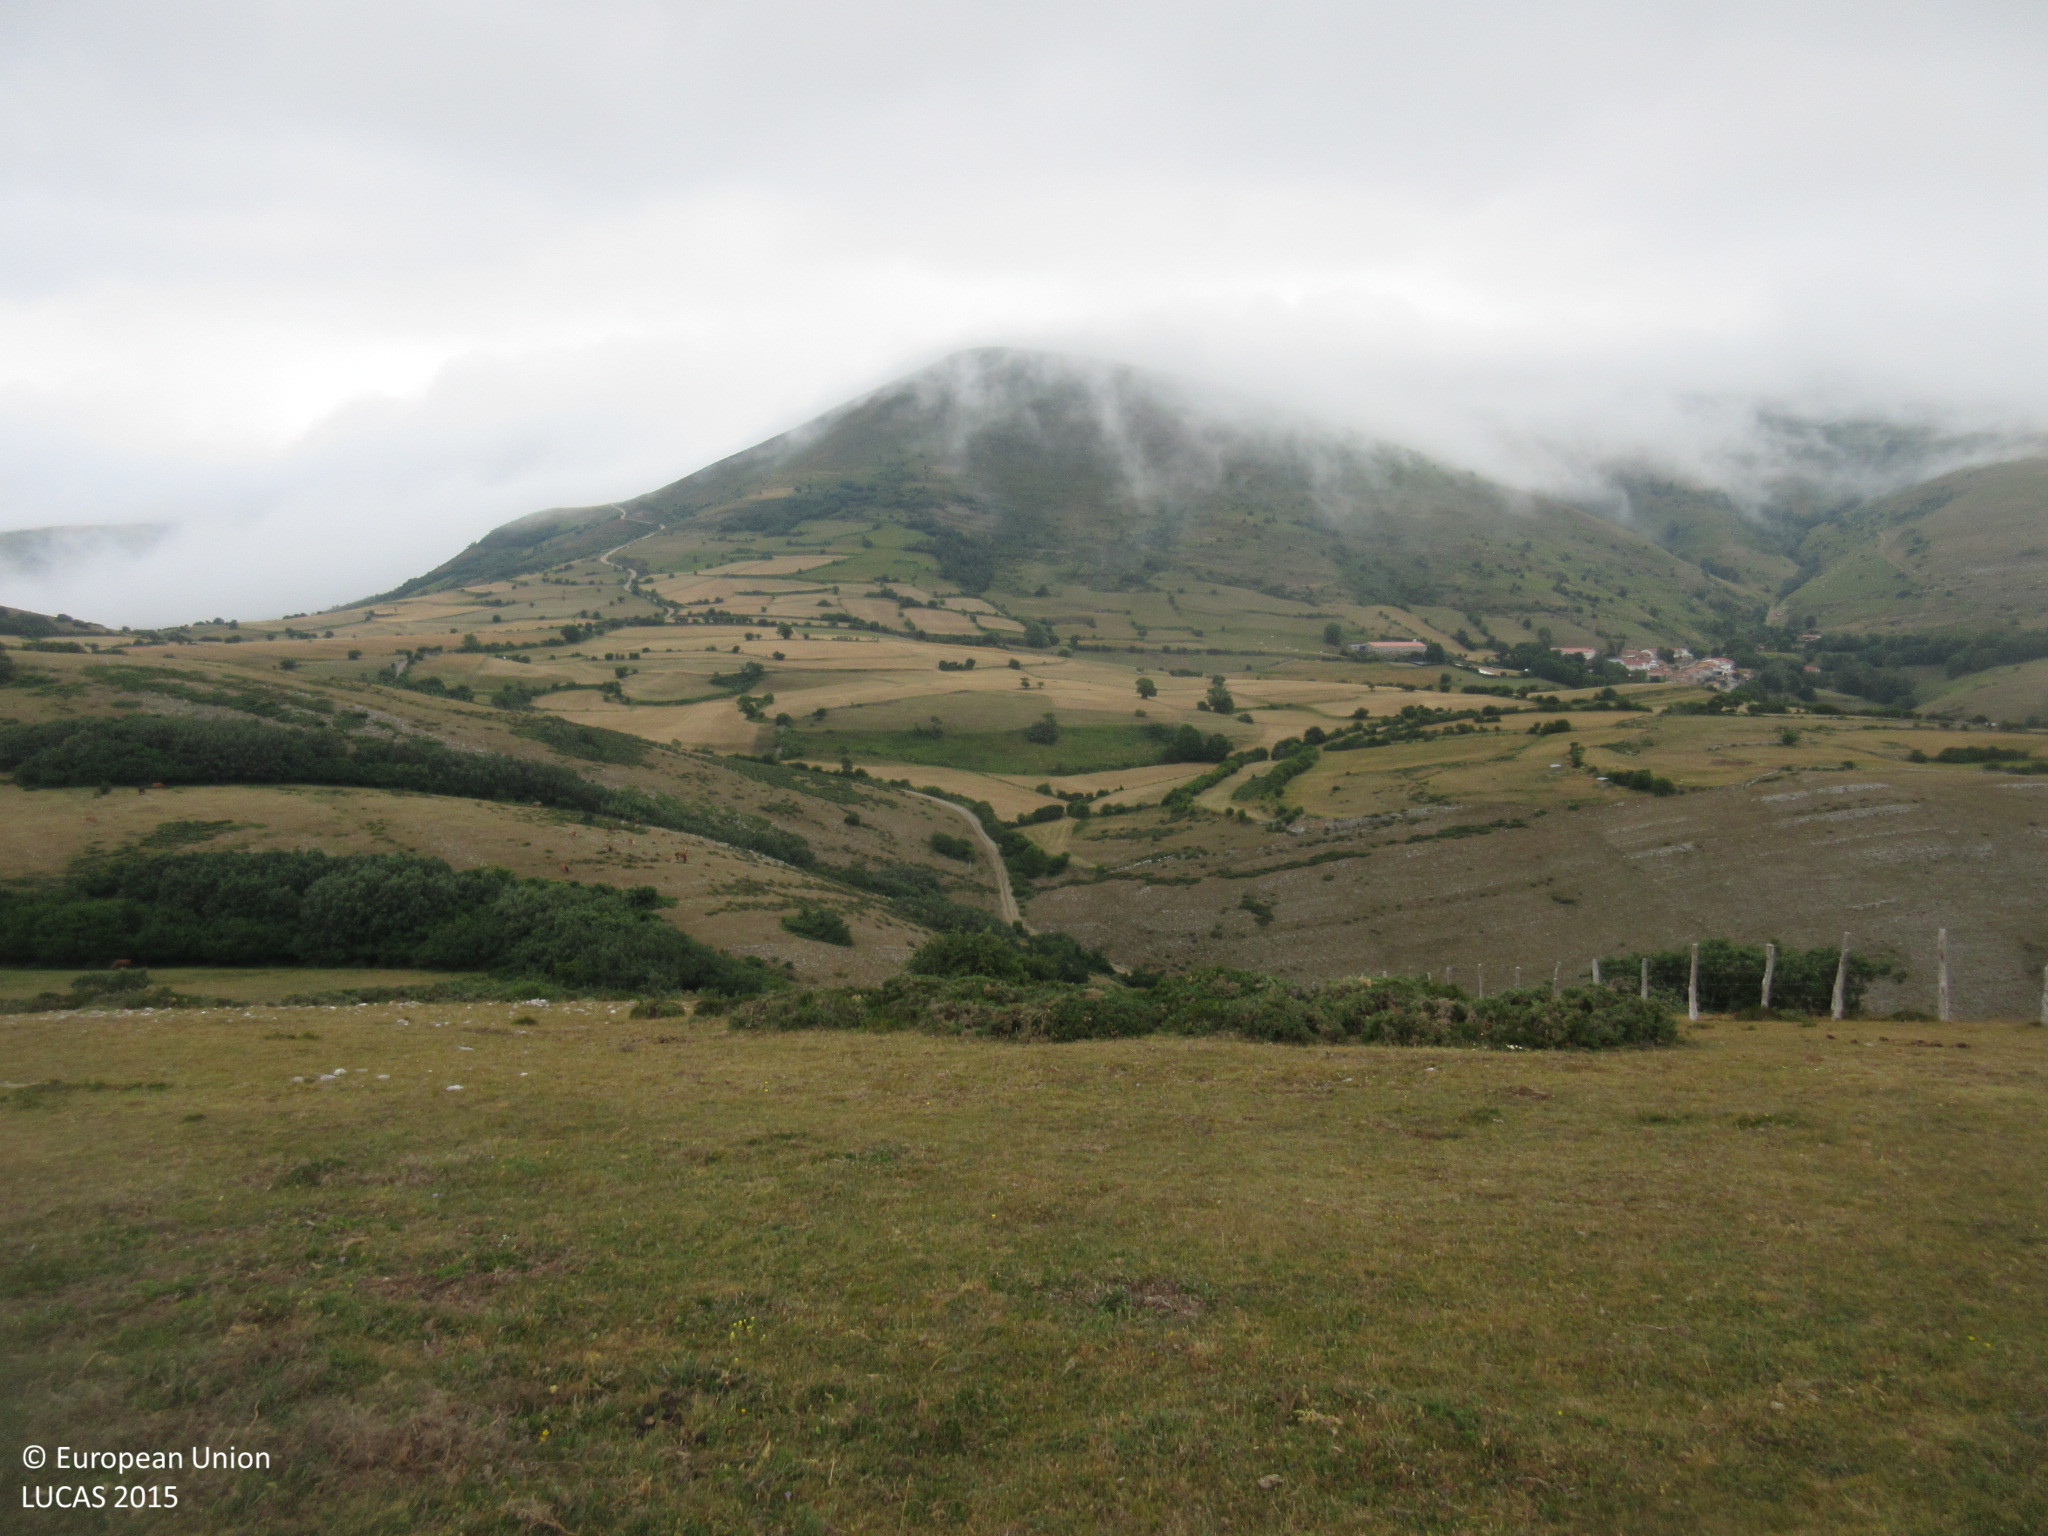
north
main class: Grassland
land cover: Grassland without tree/shrub cover
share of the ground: > 75 %
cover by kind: herbaceous plants 95 %, shrubs 5 %
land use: Agriculture (excluding fallow land and kitchen gardens)
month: July
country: ES
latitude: 43.0241
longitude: -4.1755
